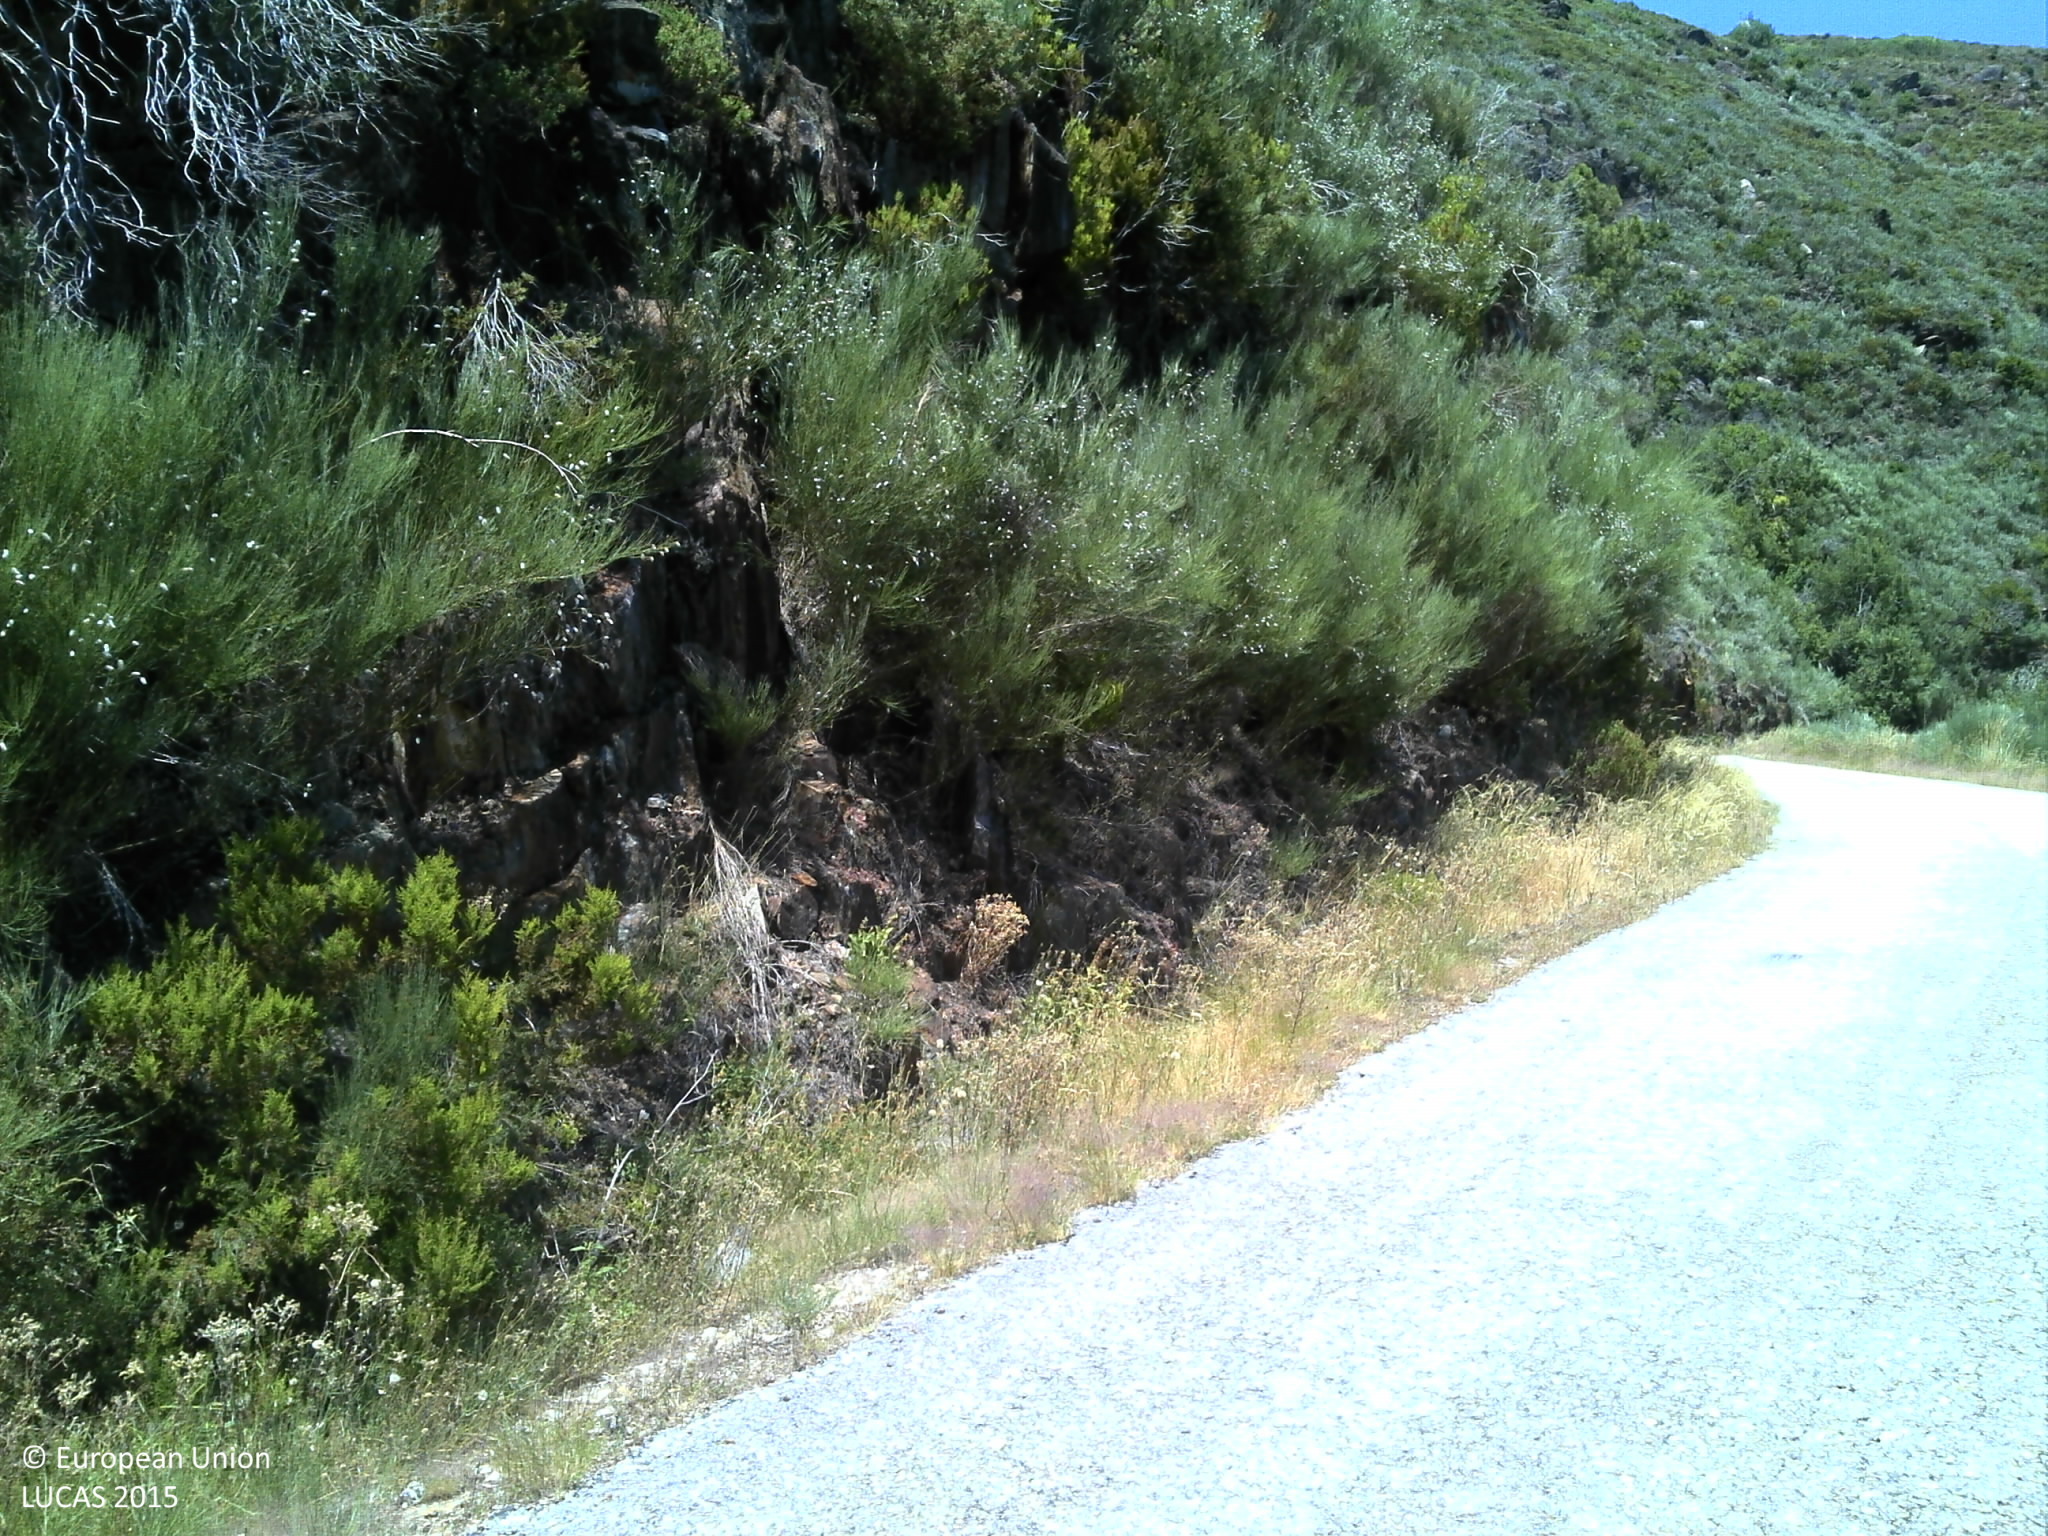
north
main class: Shrubland
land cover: Shrubland without tree cover
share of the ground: > 75 %
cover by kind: shrubs 85 %, unconsolidated bare surface 15 %
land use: Semi-natural and natural areas not in use
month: June
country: PT
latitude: 40.8233
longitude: -8.0954
